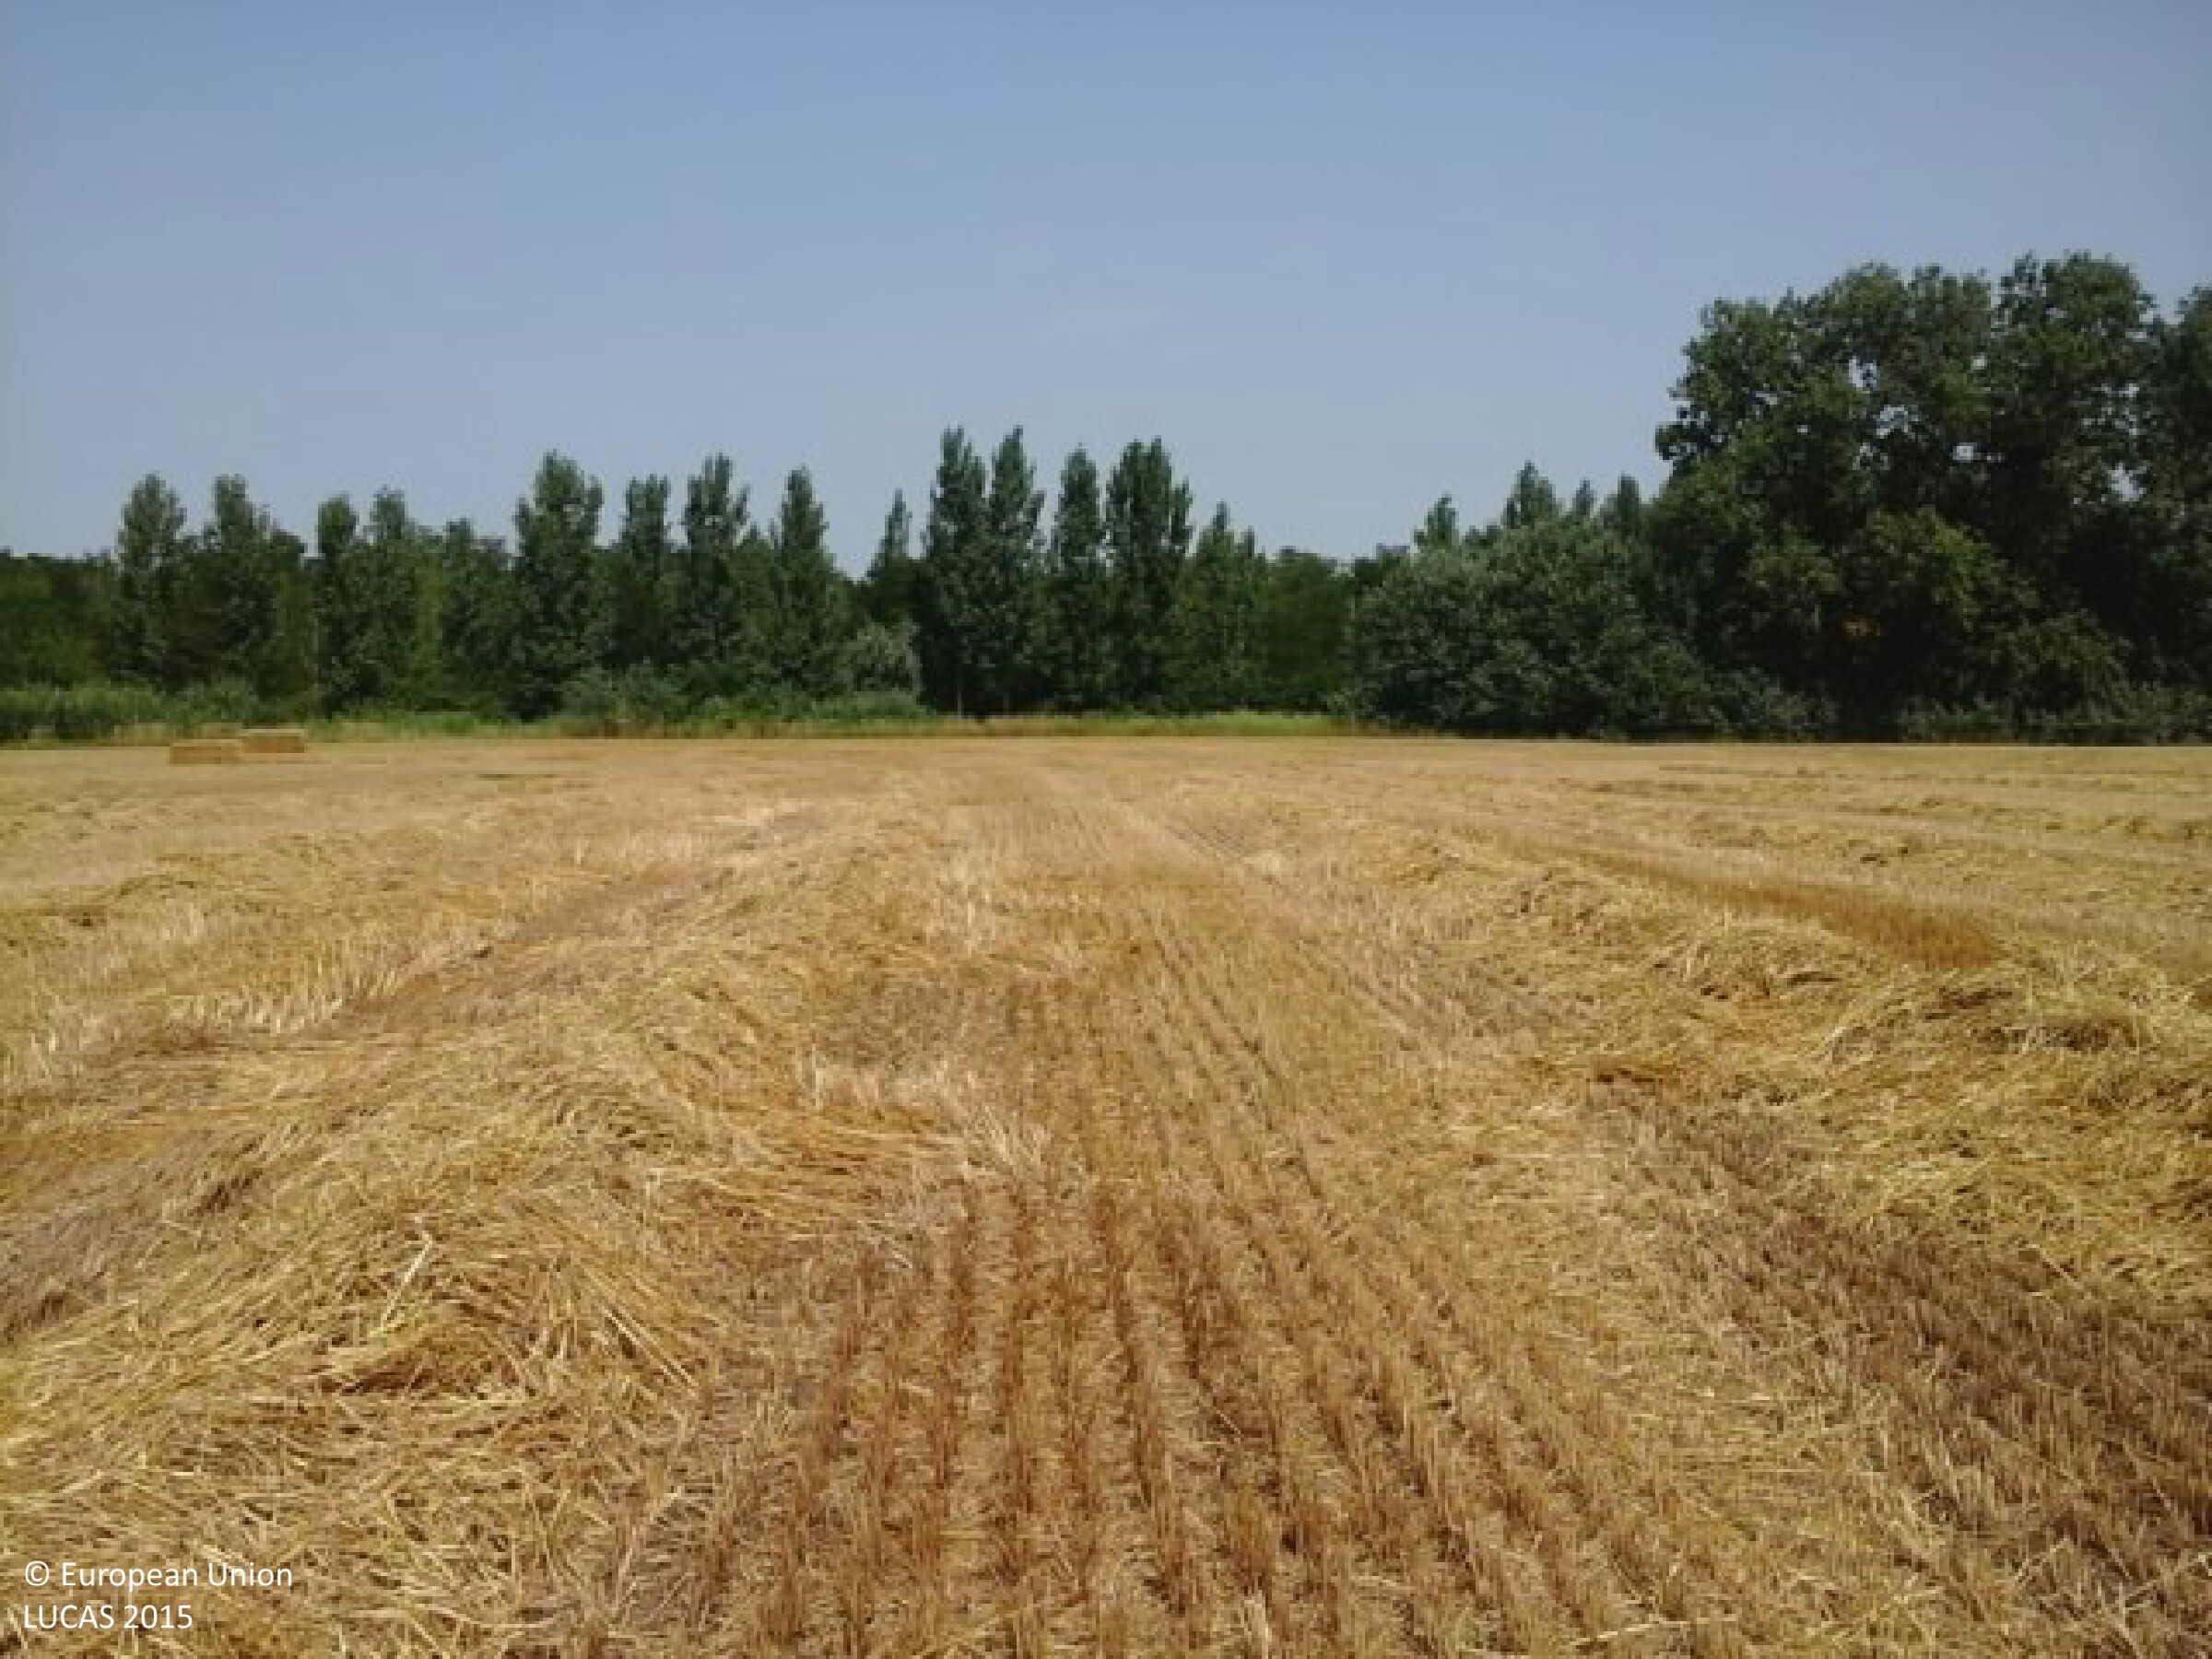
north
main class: Cropland
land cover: Common wheat
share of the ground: 50 - 75 %
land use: Agriculture (excluding fallow land and kitchen gardens)
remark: Harvested field
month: July
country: HU
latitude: 46.3664
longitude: 21.1466
